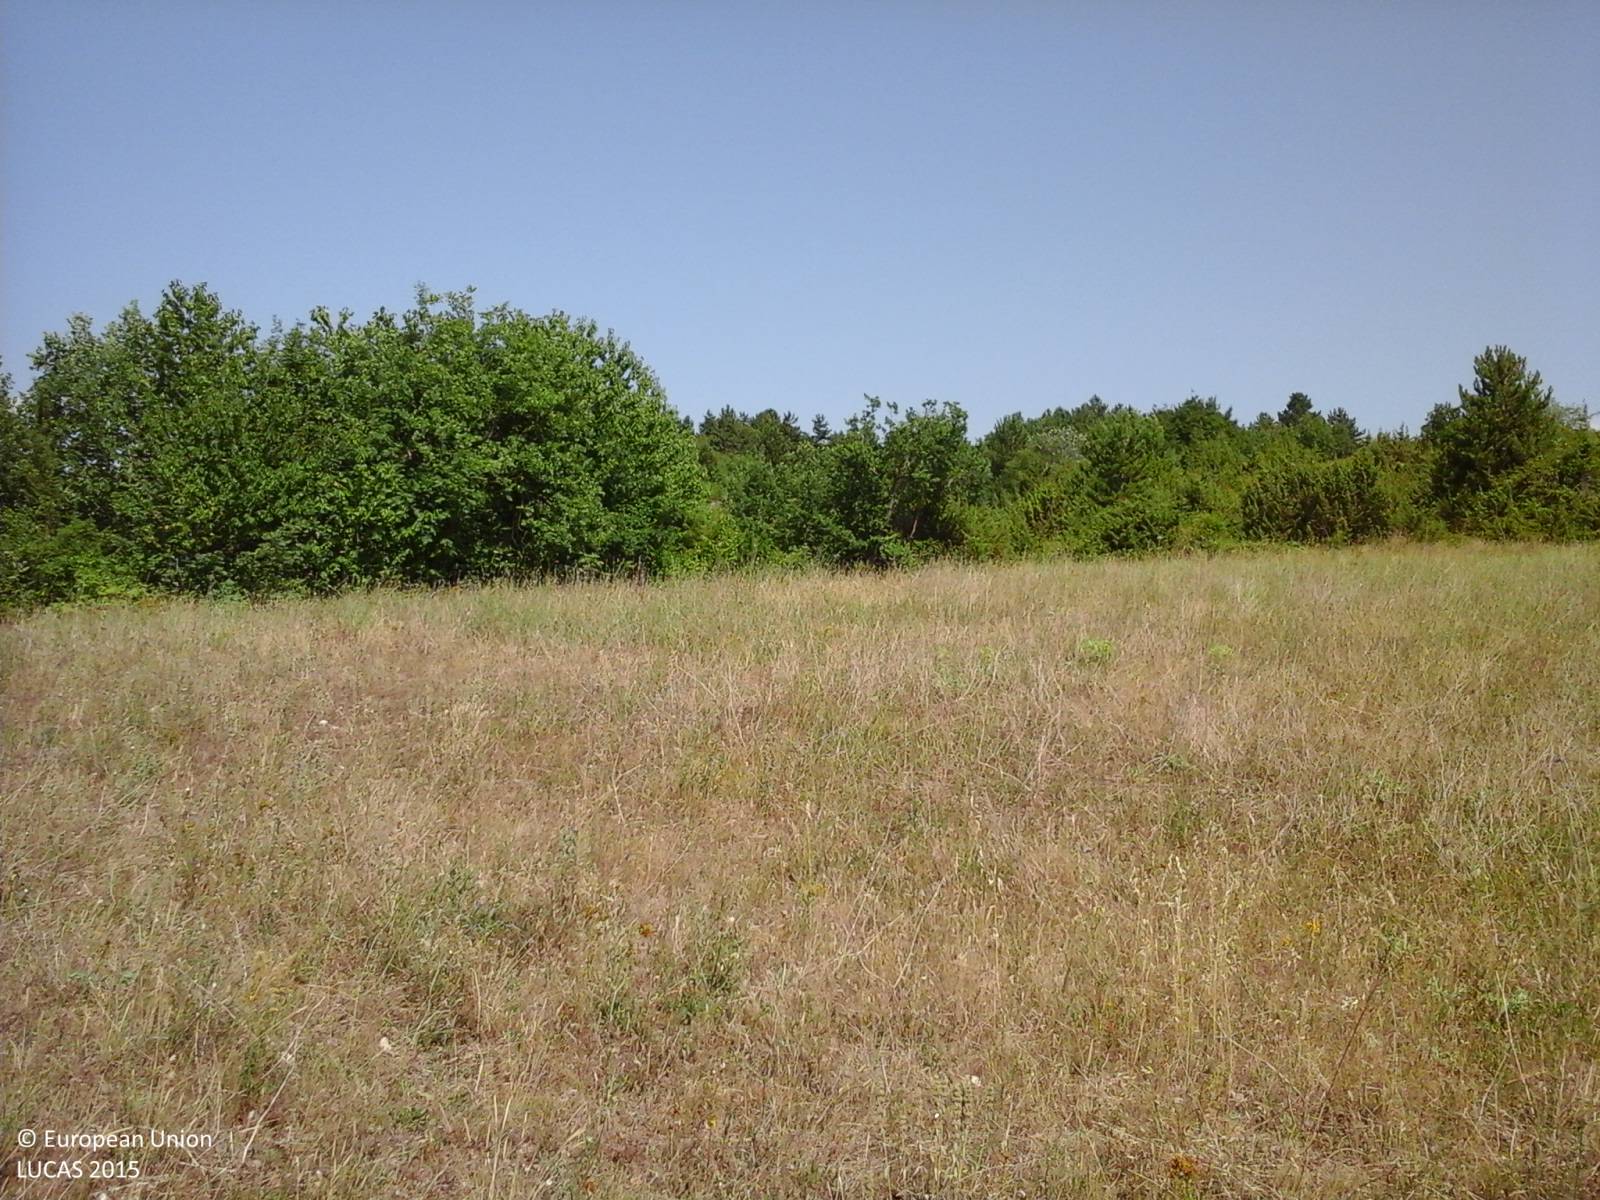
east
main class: Woodland
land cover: Broadleaved woodland
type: thermophilous deciduous forest
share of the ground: > 75 %
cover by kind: broadleaved forest trees 85 %, shrubs 10 %, coniferous forest trees 5 %
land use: Forestry
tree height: > 5 m
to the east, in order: Broadleaved woodland; Grassland without tree/shrub cover; Electric lines; Grassland without tree/shrub cover; Tracks; Shrubland with sparse tree cover; Broadleaved woodland; Pine dominated coniferous woodland
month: July
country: IT
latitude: 42.4004
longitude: 13.3304
